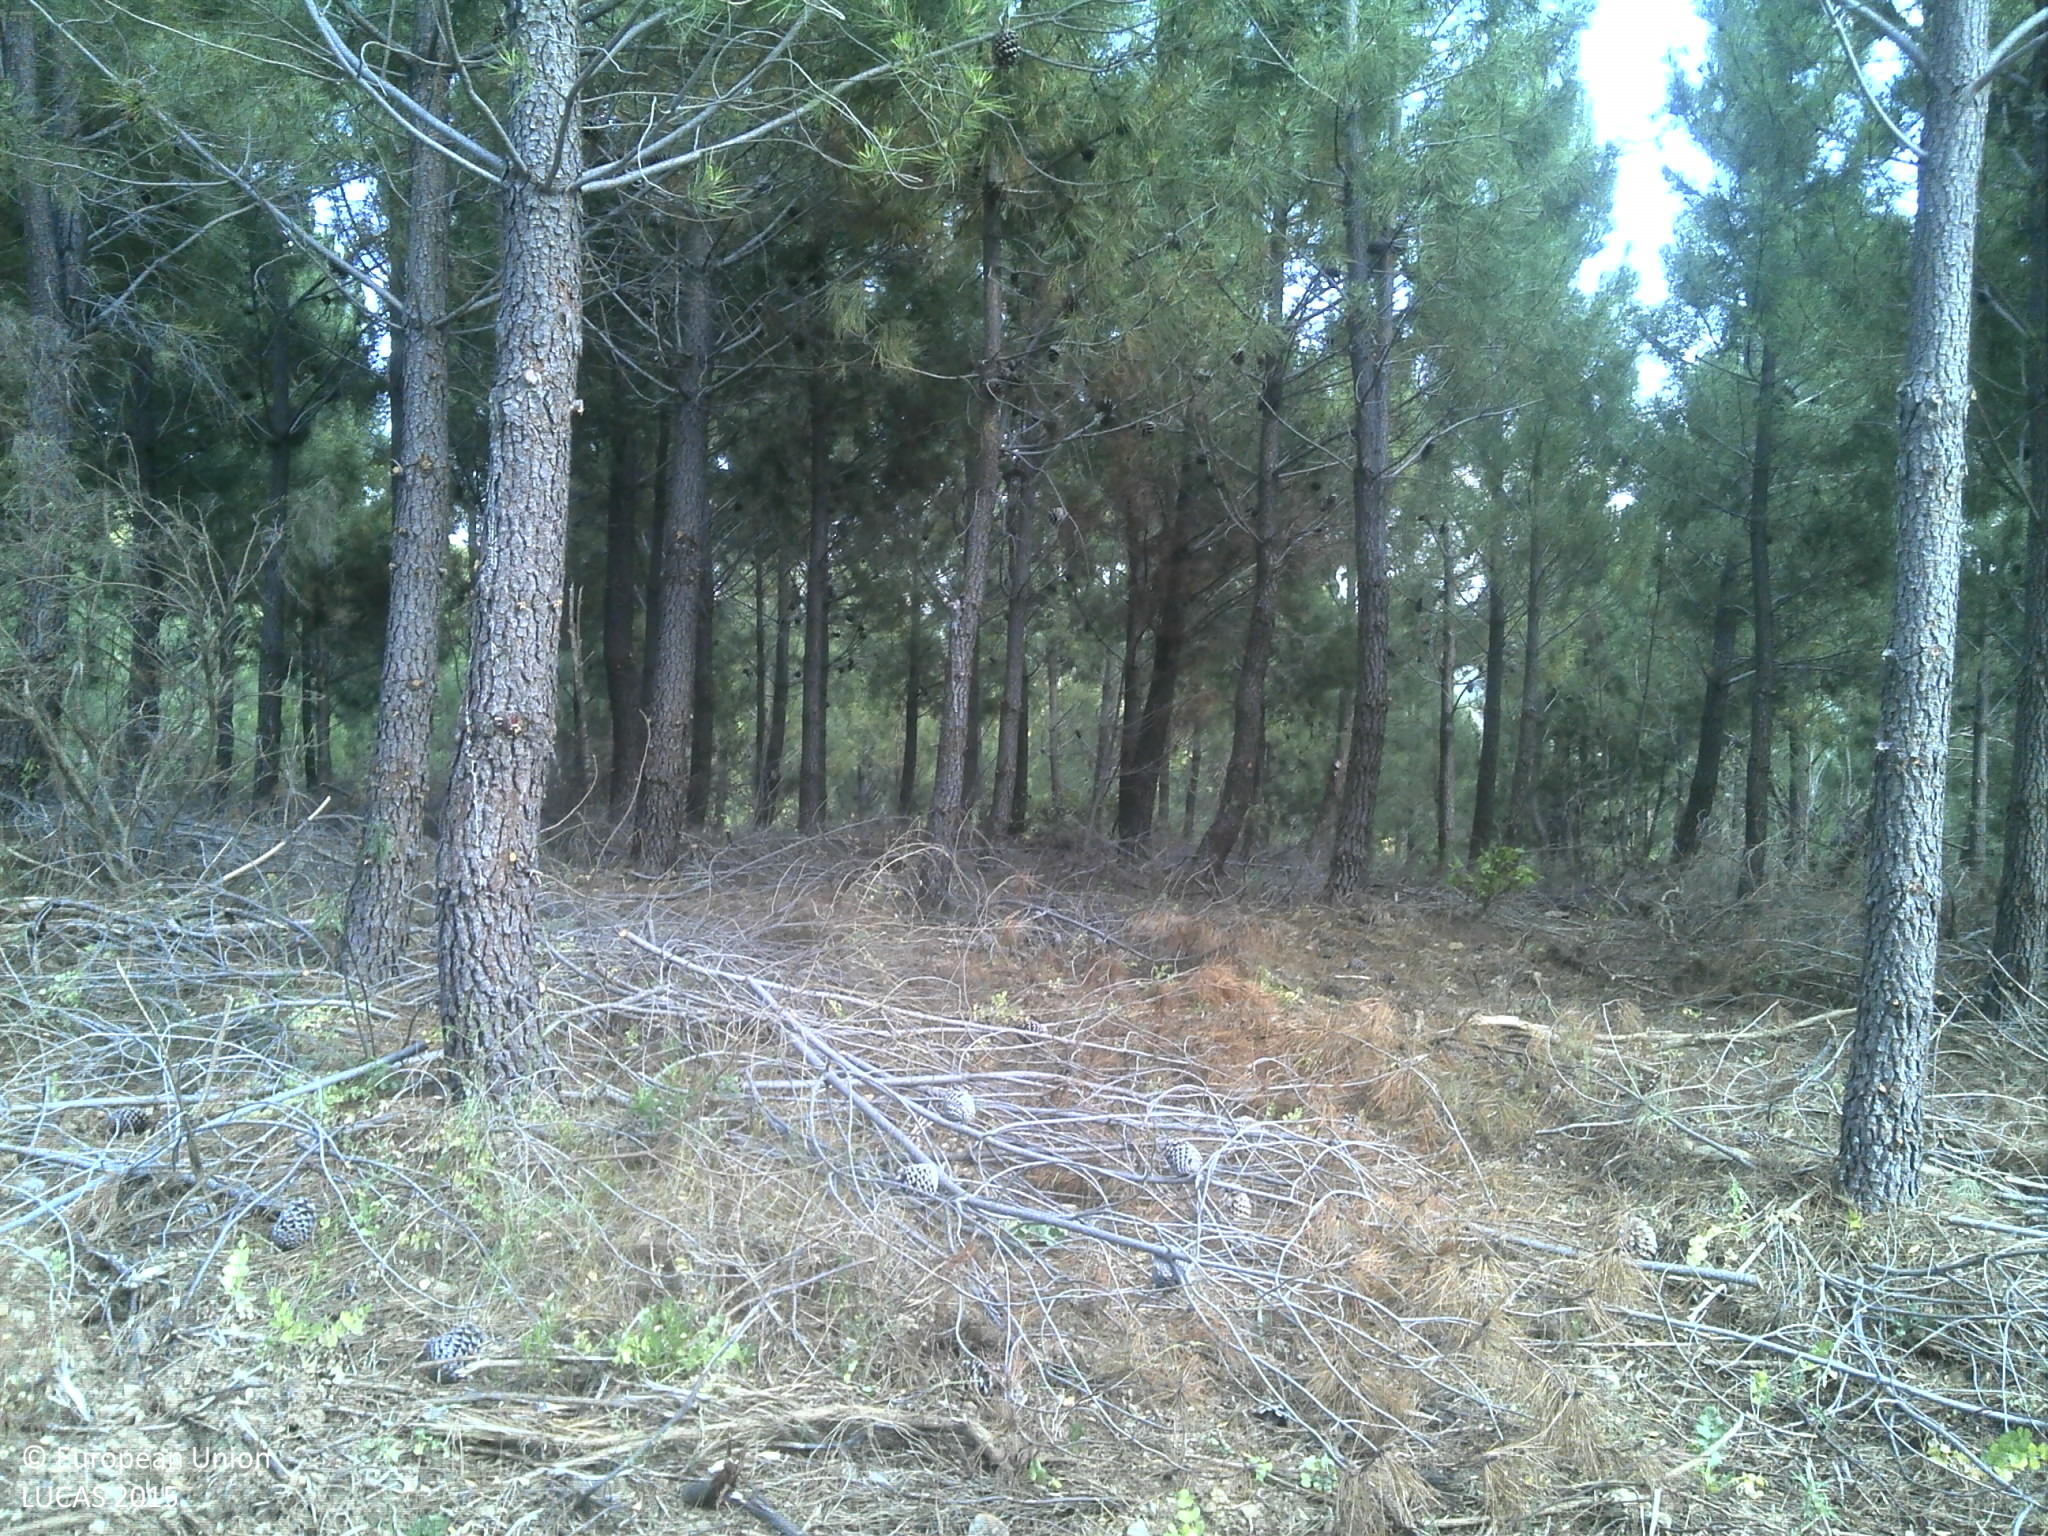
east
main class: Shrubland
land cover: Shrubland with sparse tree cover
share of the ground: 50 - 75 %
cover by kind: shrubs 75 %, unconsolidated bare surface 10 %, coniferous forest trees 5 %
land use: Forestry
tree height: > 5 m
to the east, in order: Shrubland with sparse tree cover; Tracks; Shrubland with sparse tree cover; Tracks; Shrubland with sparse tree cover; Other structural elements; Shrubland with sparse tree cover
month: June
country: PT
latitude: 40.2770
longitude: -7.1400
